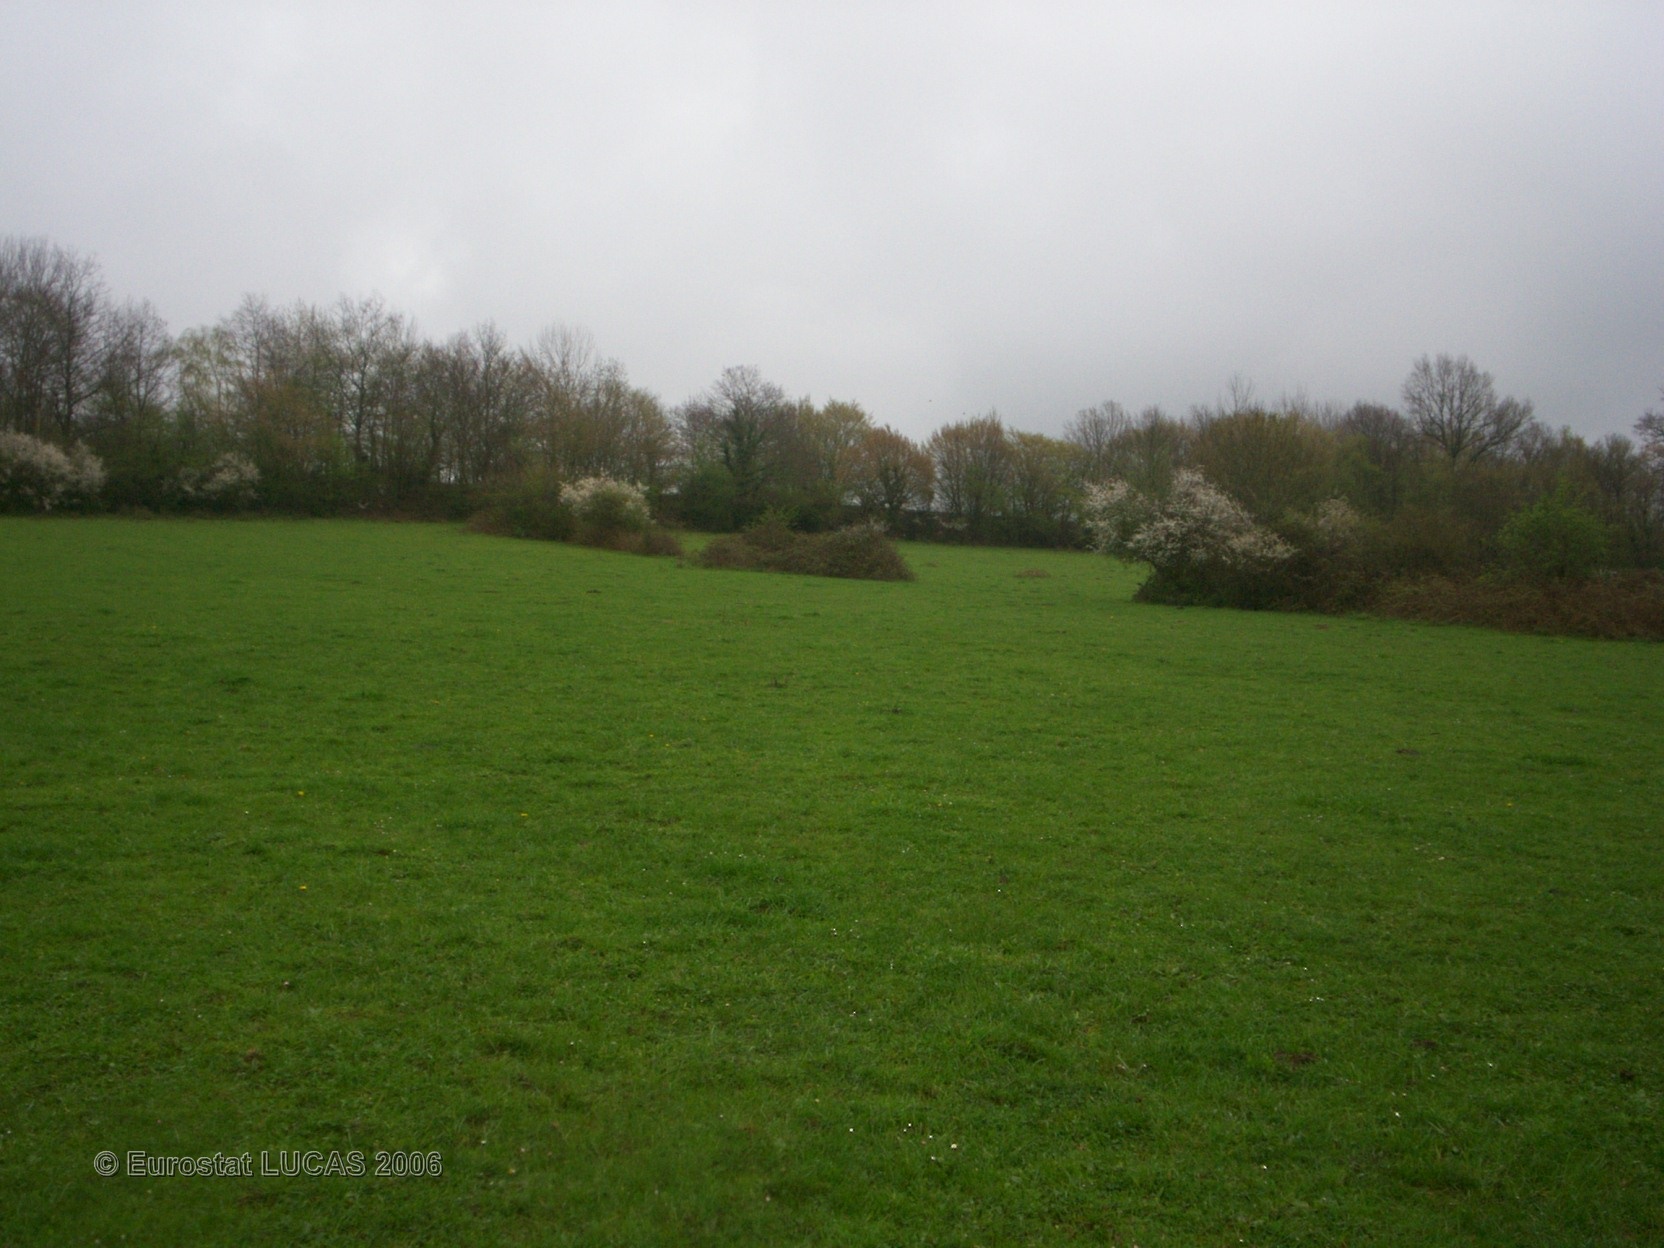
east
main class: Grassland
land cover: Grassland without tree/shrub cover
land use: Agriculture (excluding fallow land and kitchen gardens)
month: April
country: FR
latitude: 47.5309
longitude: 2.9940
